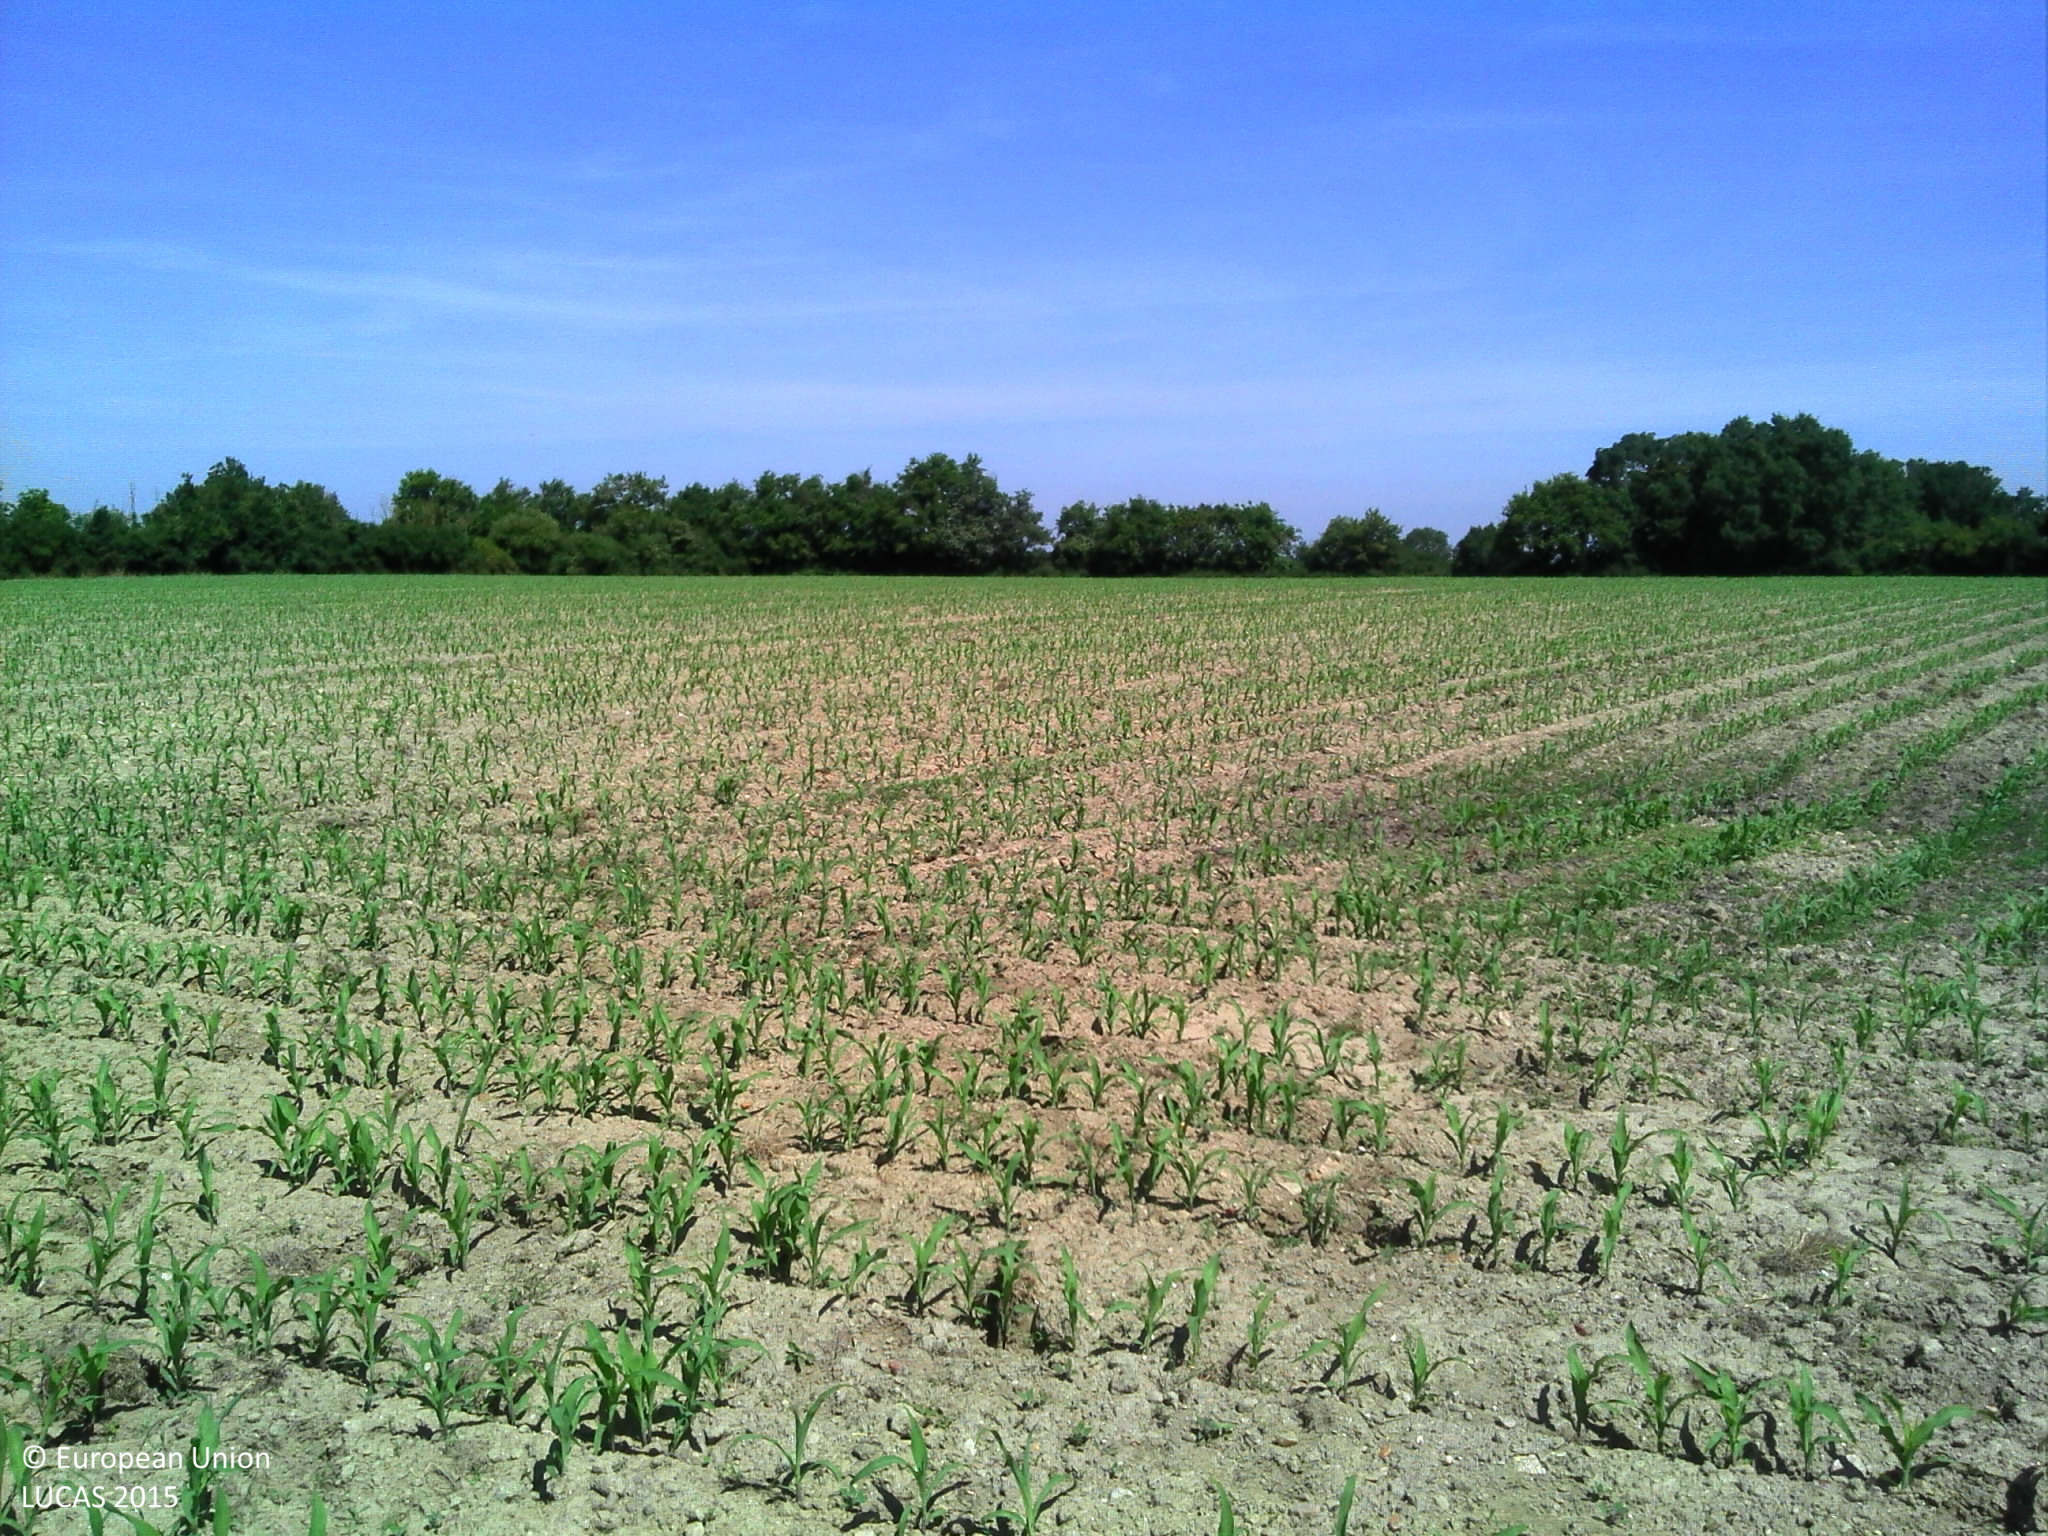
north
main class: Cropland
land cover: Maize
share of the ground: 10 - 25 %
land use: Agriculture (excluding fallow land and kitchen gardens)
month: June
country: FR
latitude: 46.9504
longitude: -1.8035
